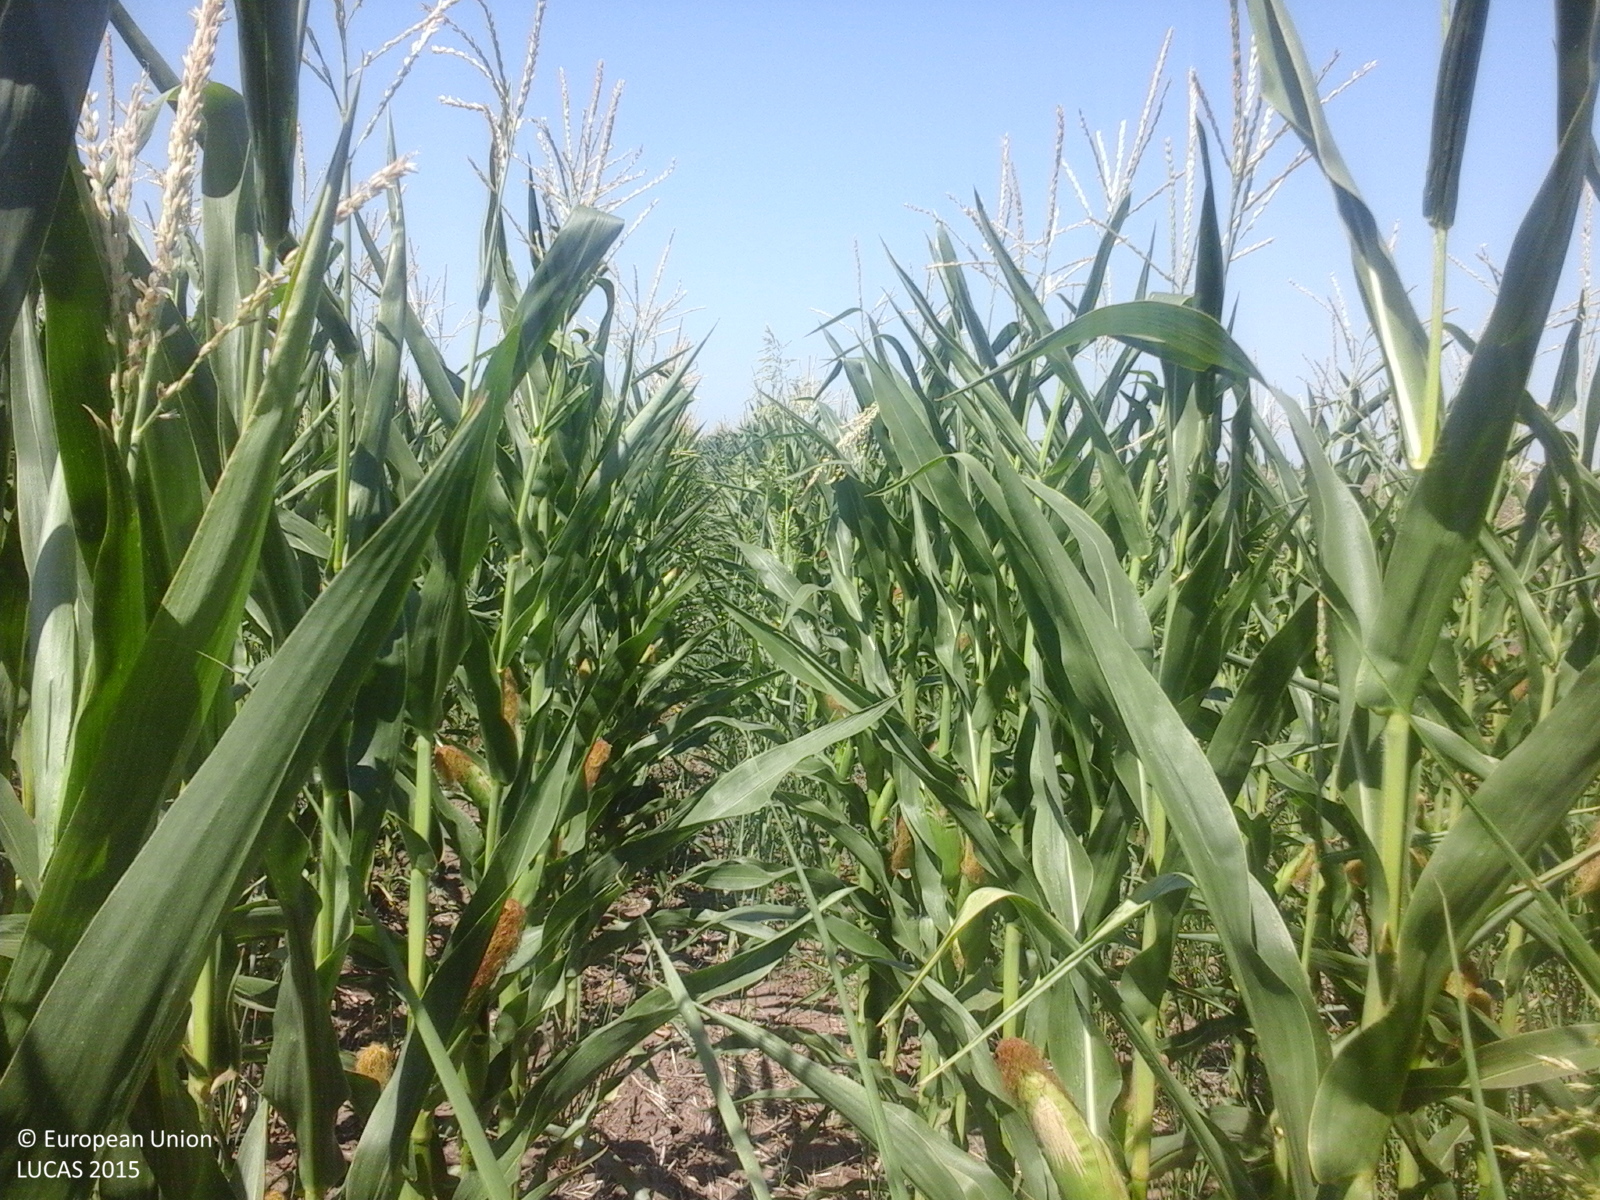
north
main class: Cropland
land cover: Maize
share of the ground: > 75 %
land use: Agriculture (excluding fallow land and kitchen gardens)
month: July
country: RO
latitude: 44.2252
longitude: 26.6534
